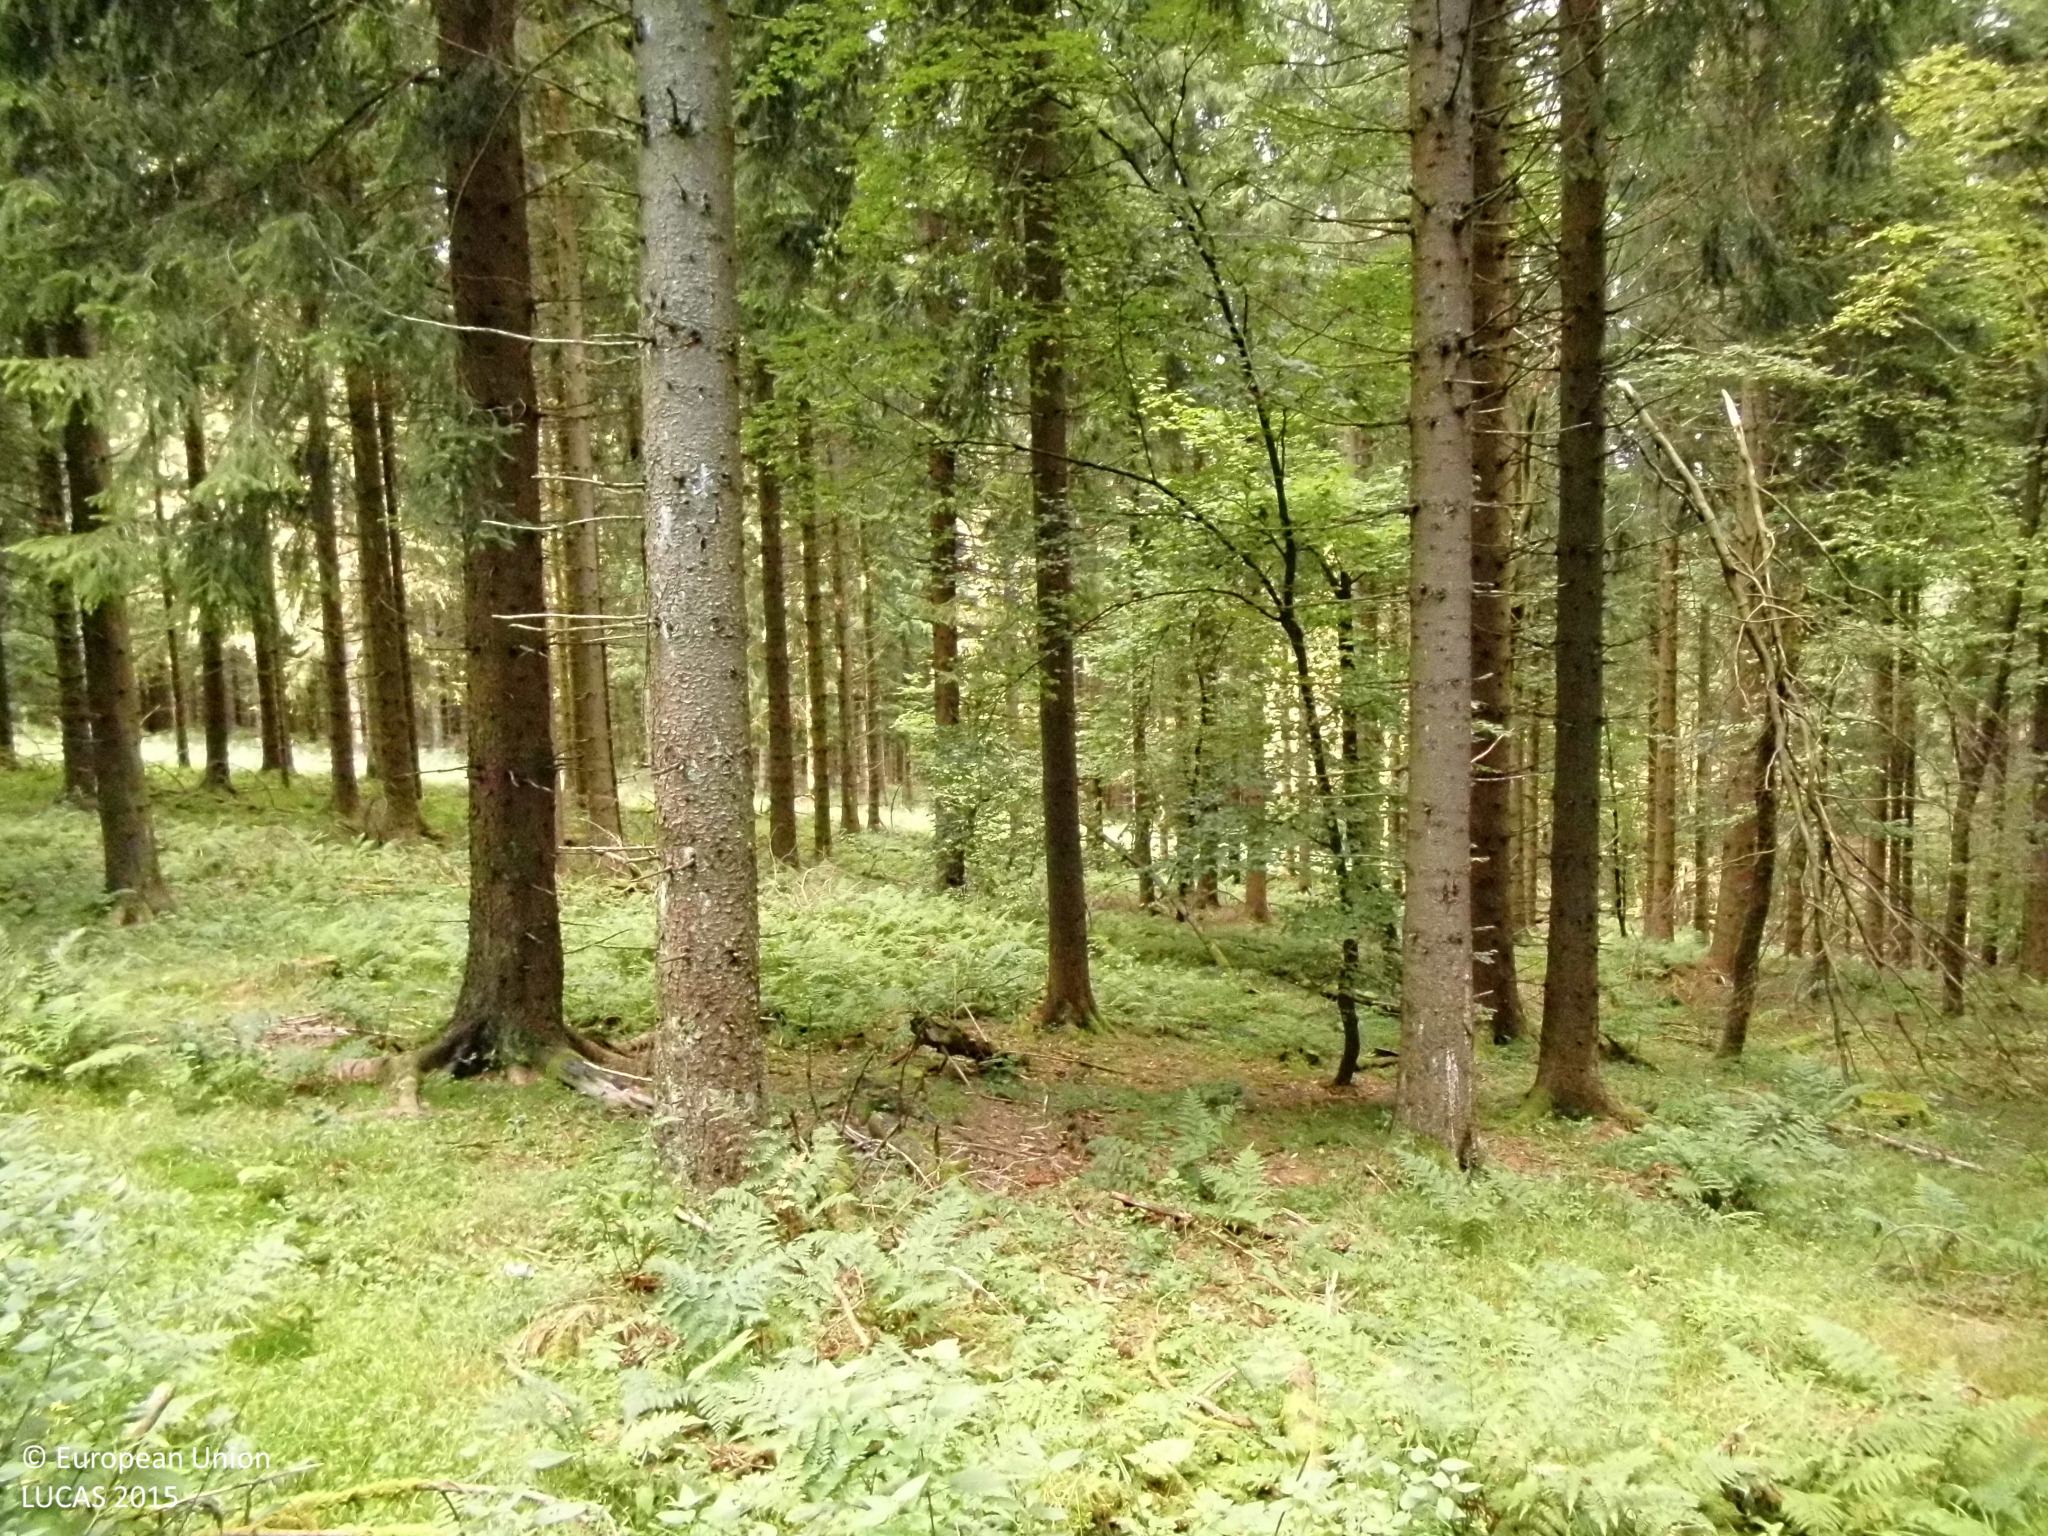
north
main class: Artificial land
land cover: Non built-up linear features
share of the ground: > 75 %
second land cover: Grassland without tree/shrub cover
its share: > 75 %
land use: Forestry
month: September
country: DE
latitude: 51.1990
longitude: 8.4691
